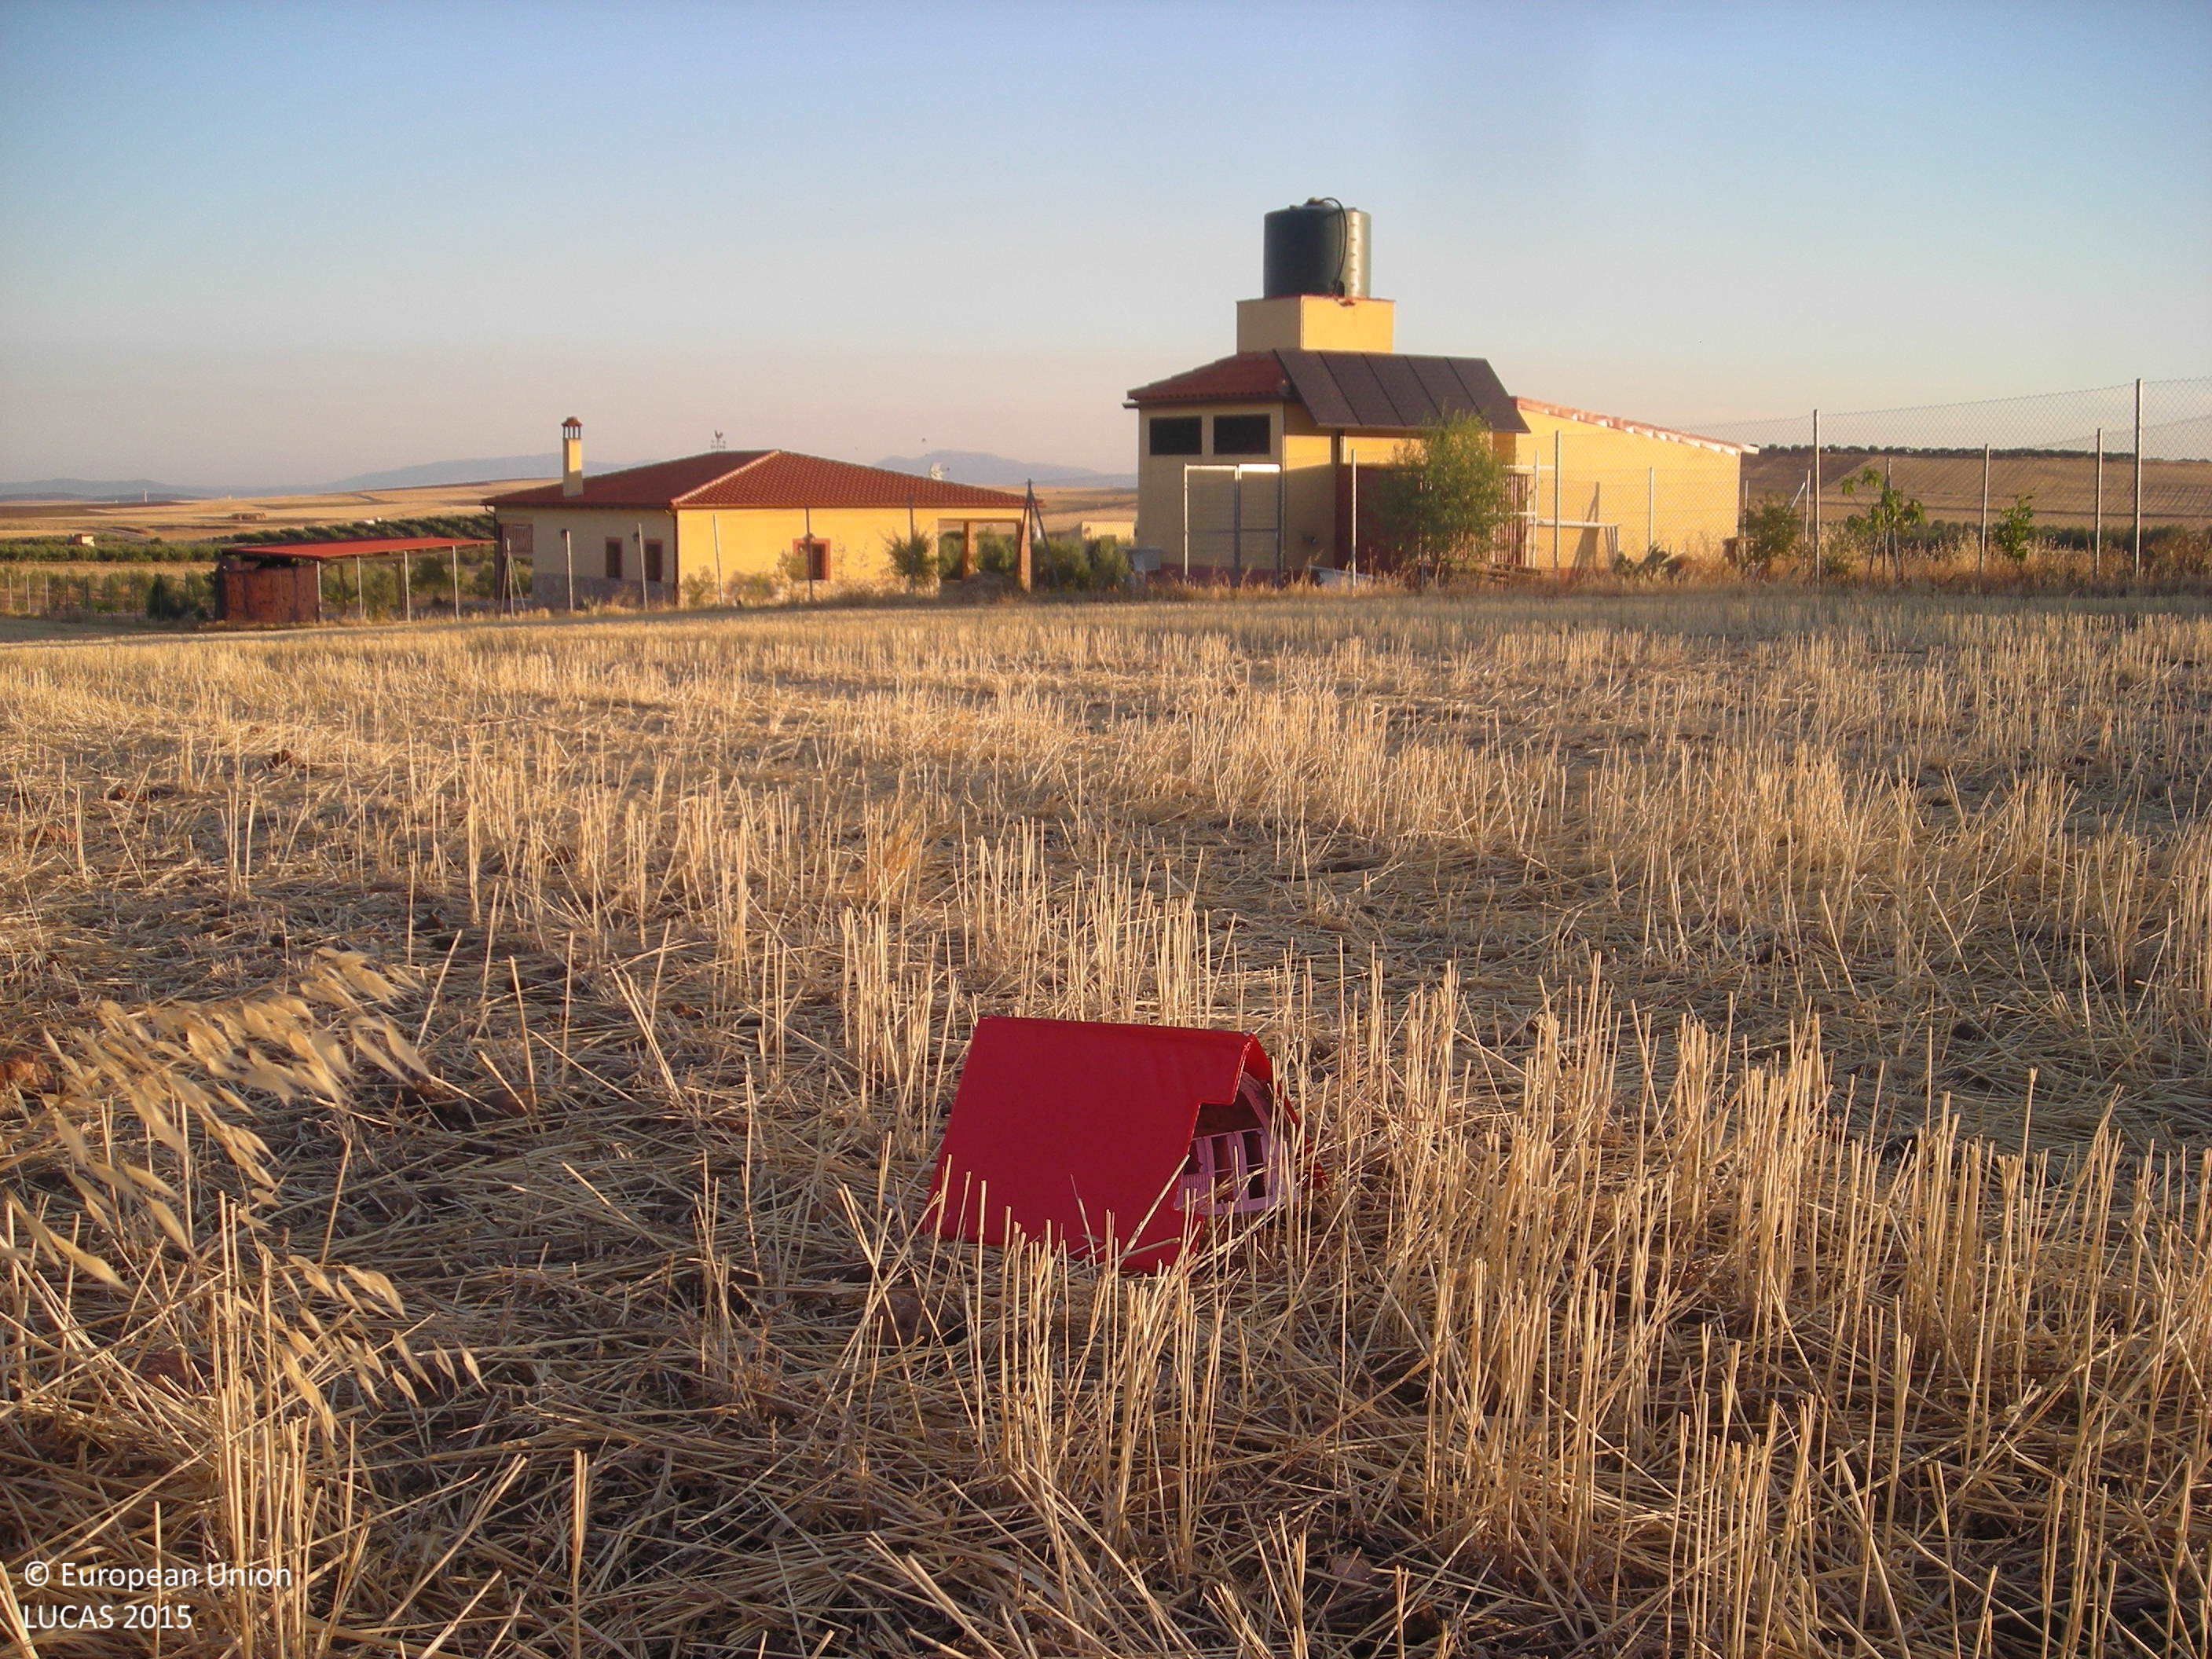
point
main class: Cropland
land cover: Common wheat
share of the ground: > 75 %
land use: Agriculture (excluding fallow land and kitchen gardens)
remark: Harvested field
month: July
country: ES
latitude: 38.9026
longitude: -5.8103
